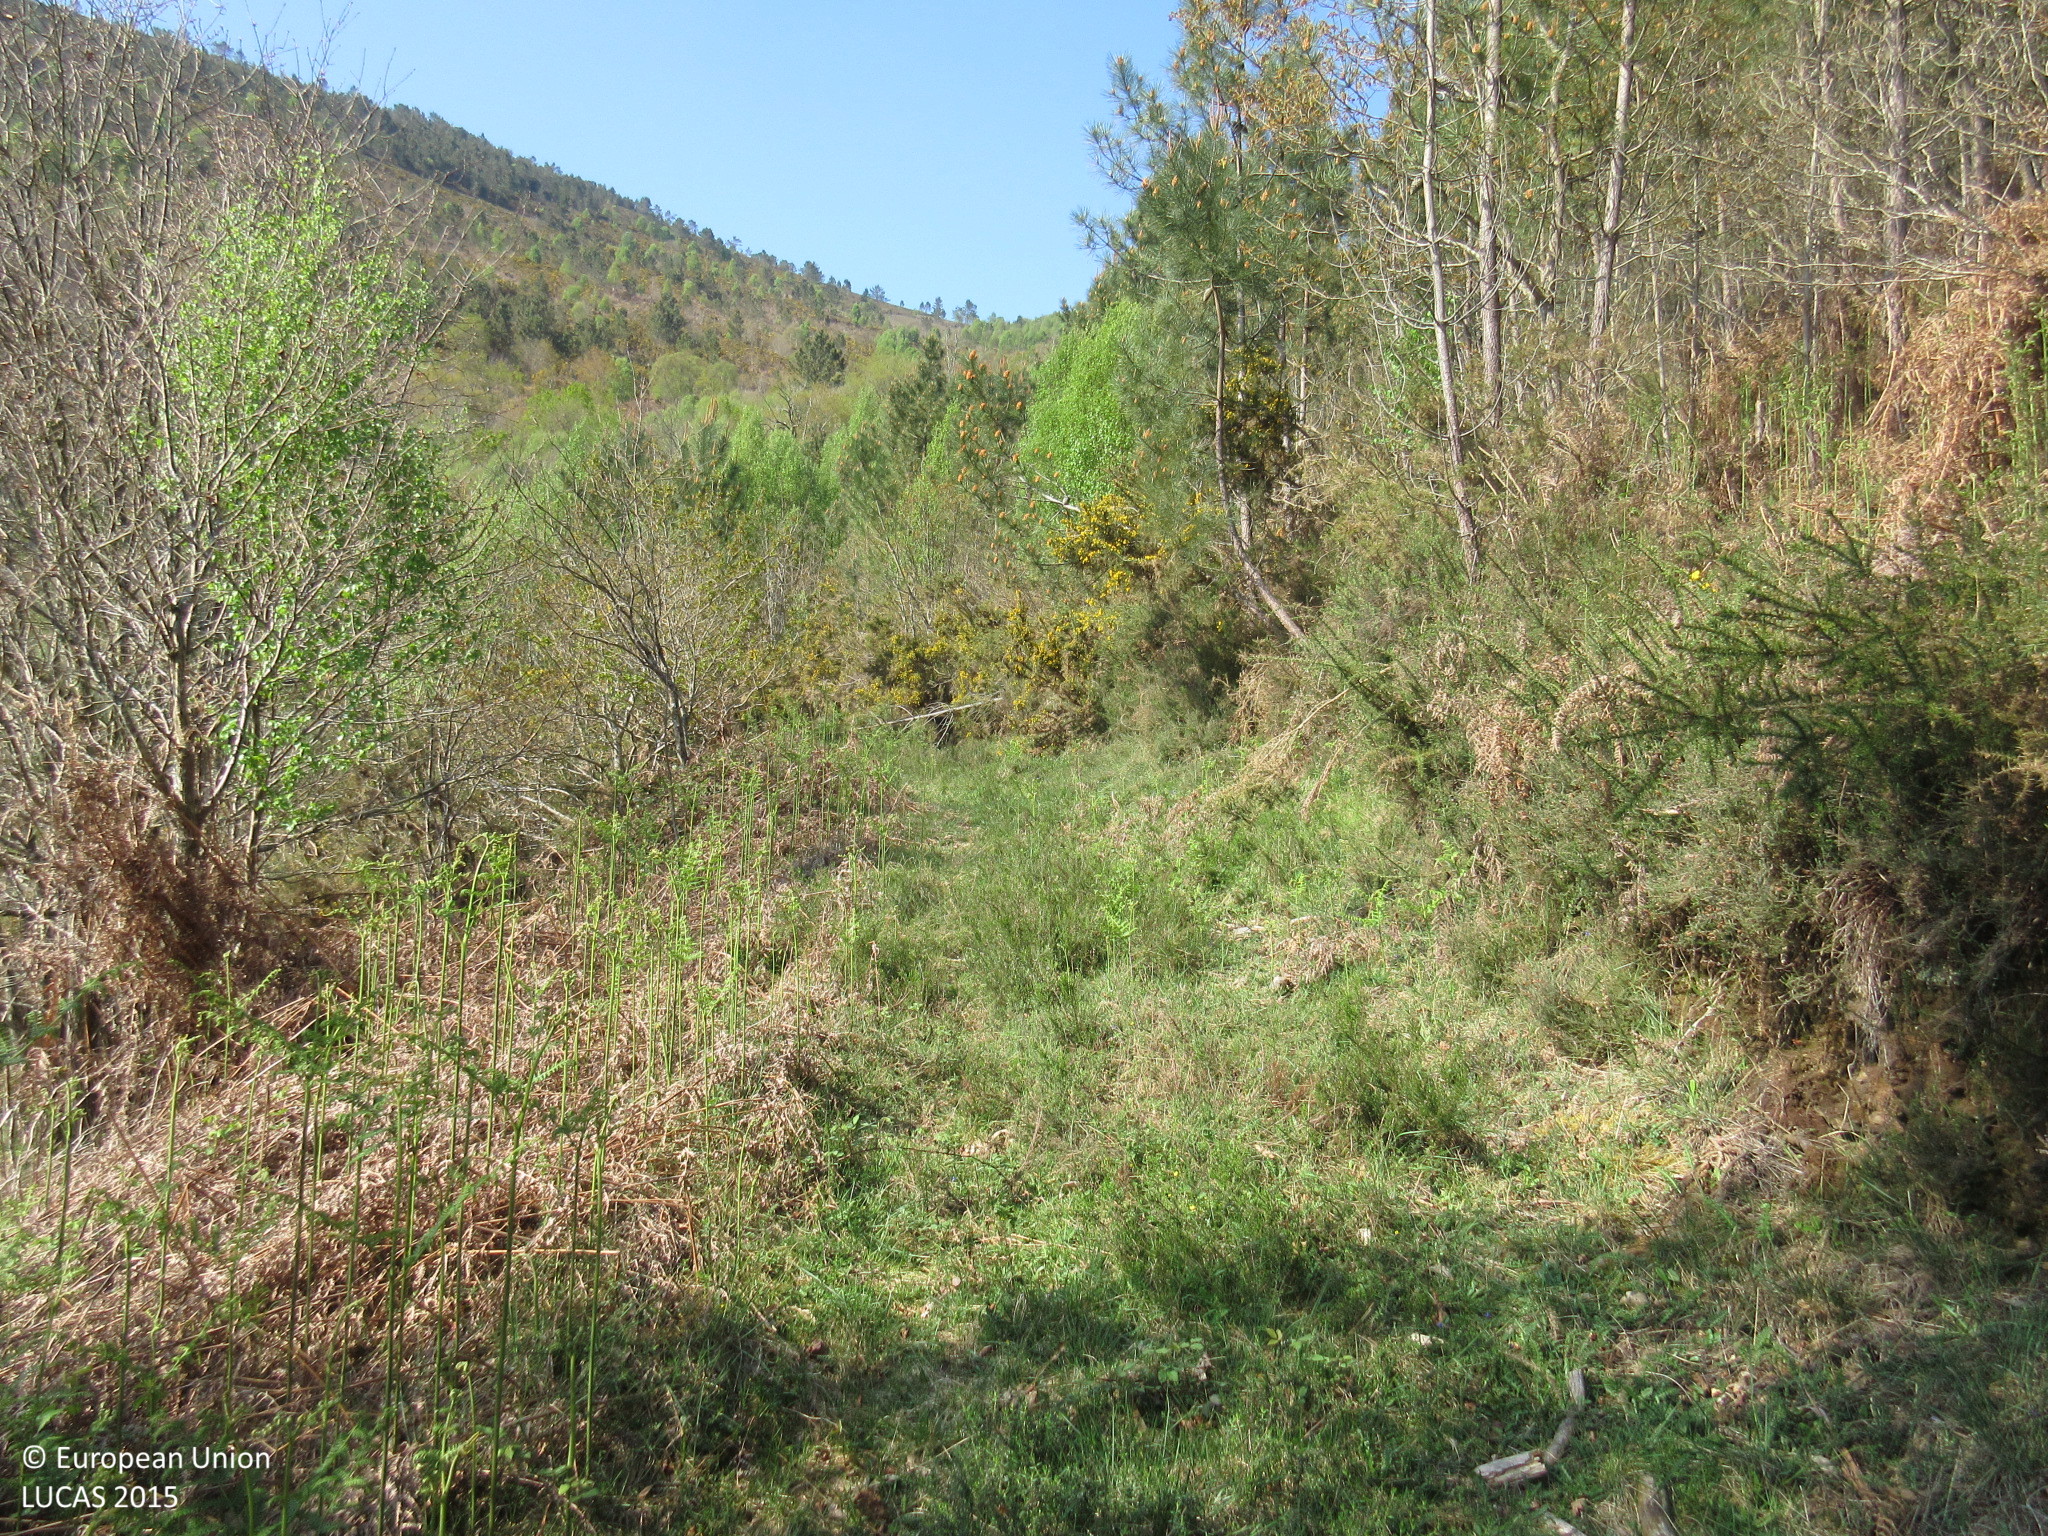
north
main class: Woodland
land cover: Broadleaved woodland
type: exotic forest
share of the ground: > 75 %
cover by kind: broadleaved forest trees 80 %, coniferous forest trees 20 %
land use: Forestry
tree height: > 5 m
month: April
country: ES
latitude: 43.4112
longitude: -6.7950
